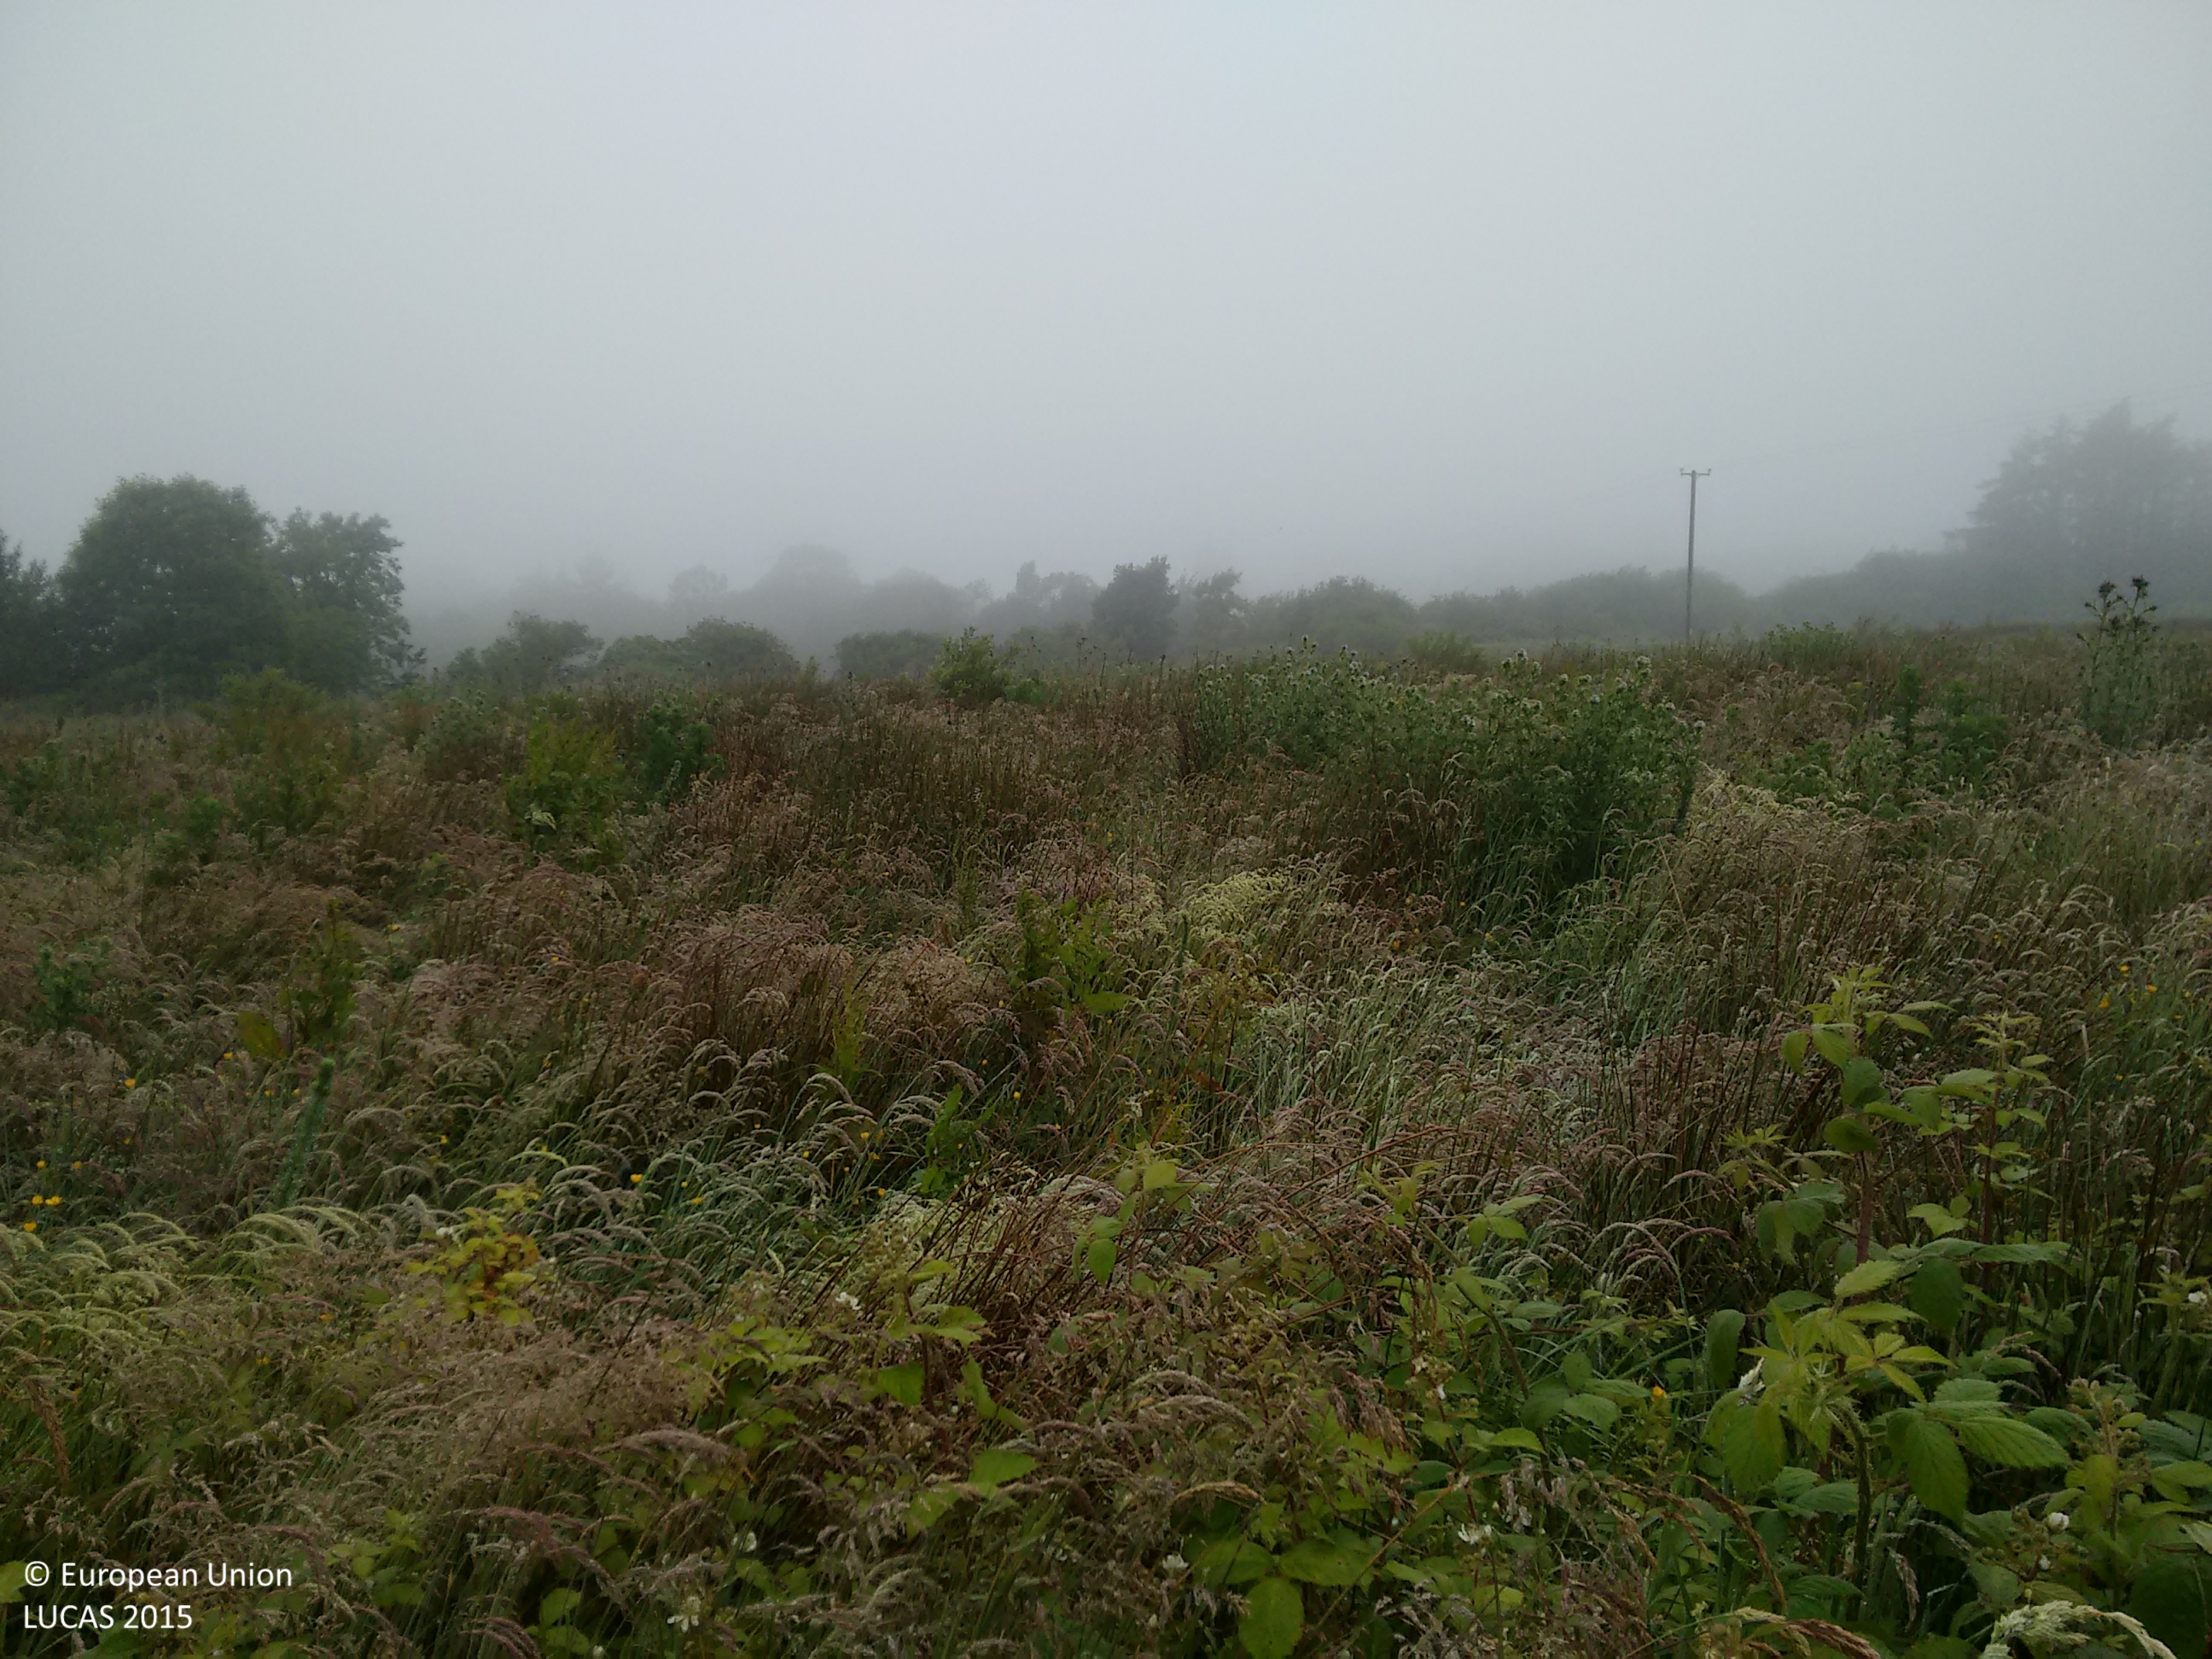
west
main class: Grassland
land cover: Spontaneously vegetated surfaces
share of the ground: > 75 %
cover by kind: herbaceous plants 95 %, shrubs 5 %
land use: Semi-natural and natural areas not in use
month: June
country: IE
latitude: 52.4039
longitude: -7.2757
